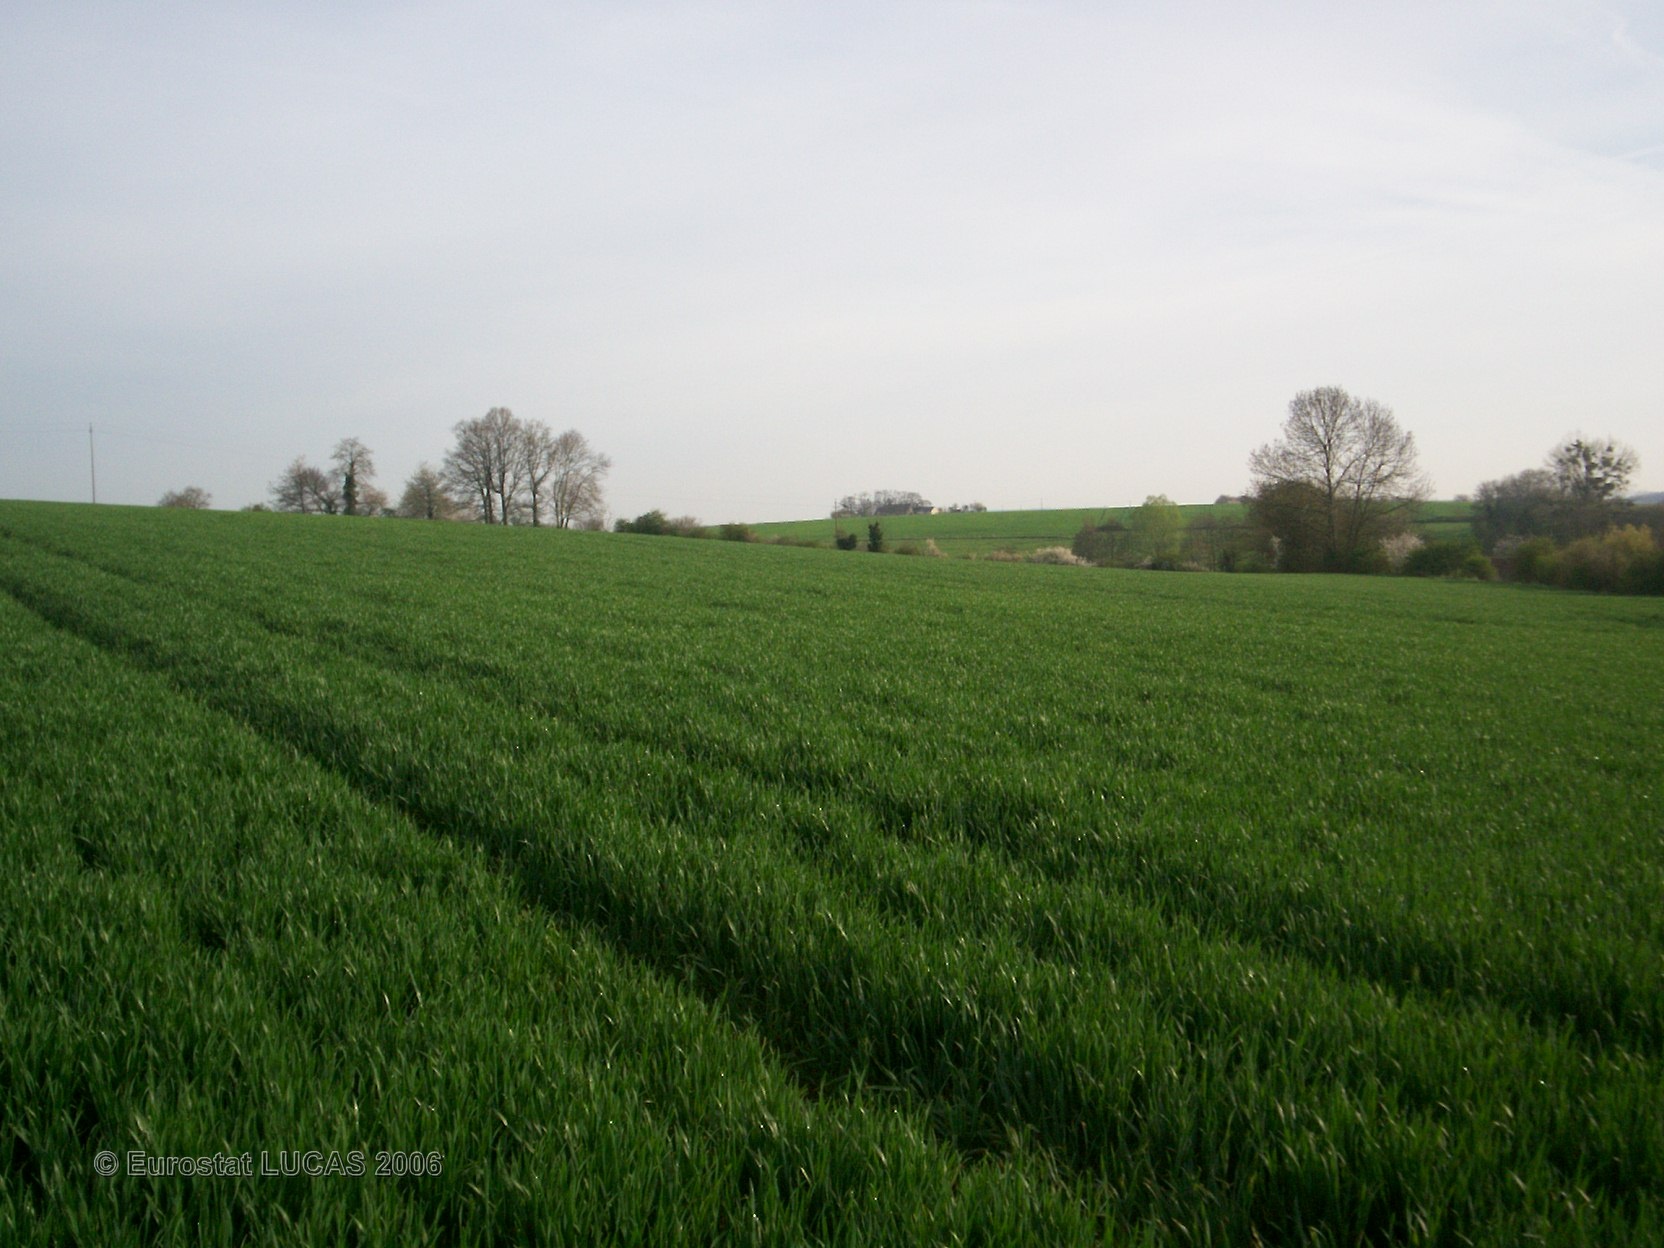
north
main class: Cropland
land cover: Common wheat
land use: Agriculture (excluding fallow land and kitchen gardens)
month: April
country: FR
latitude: 48.2685
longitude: 0.1239
